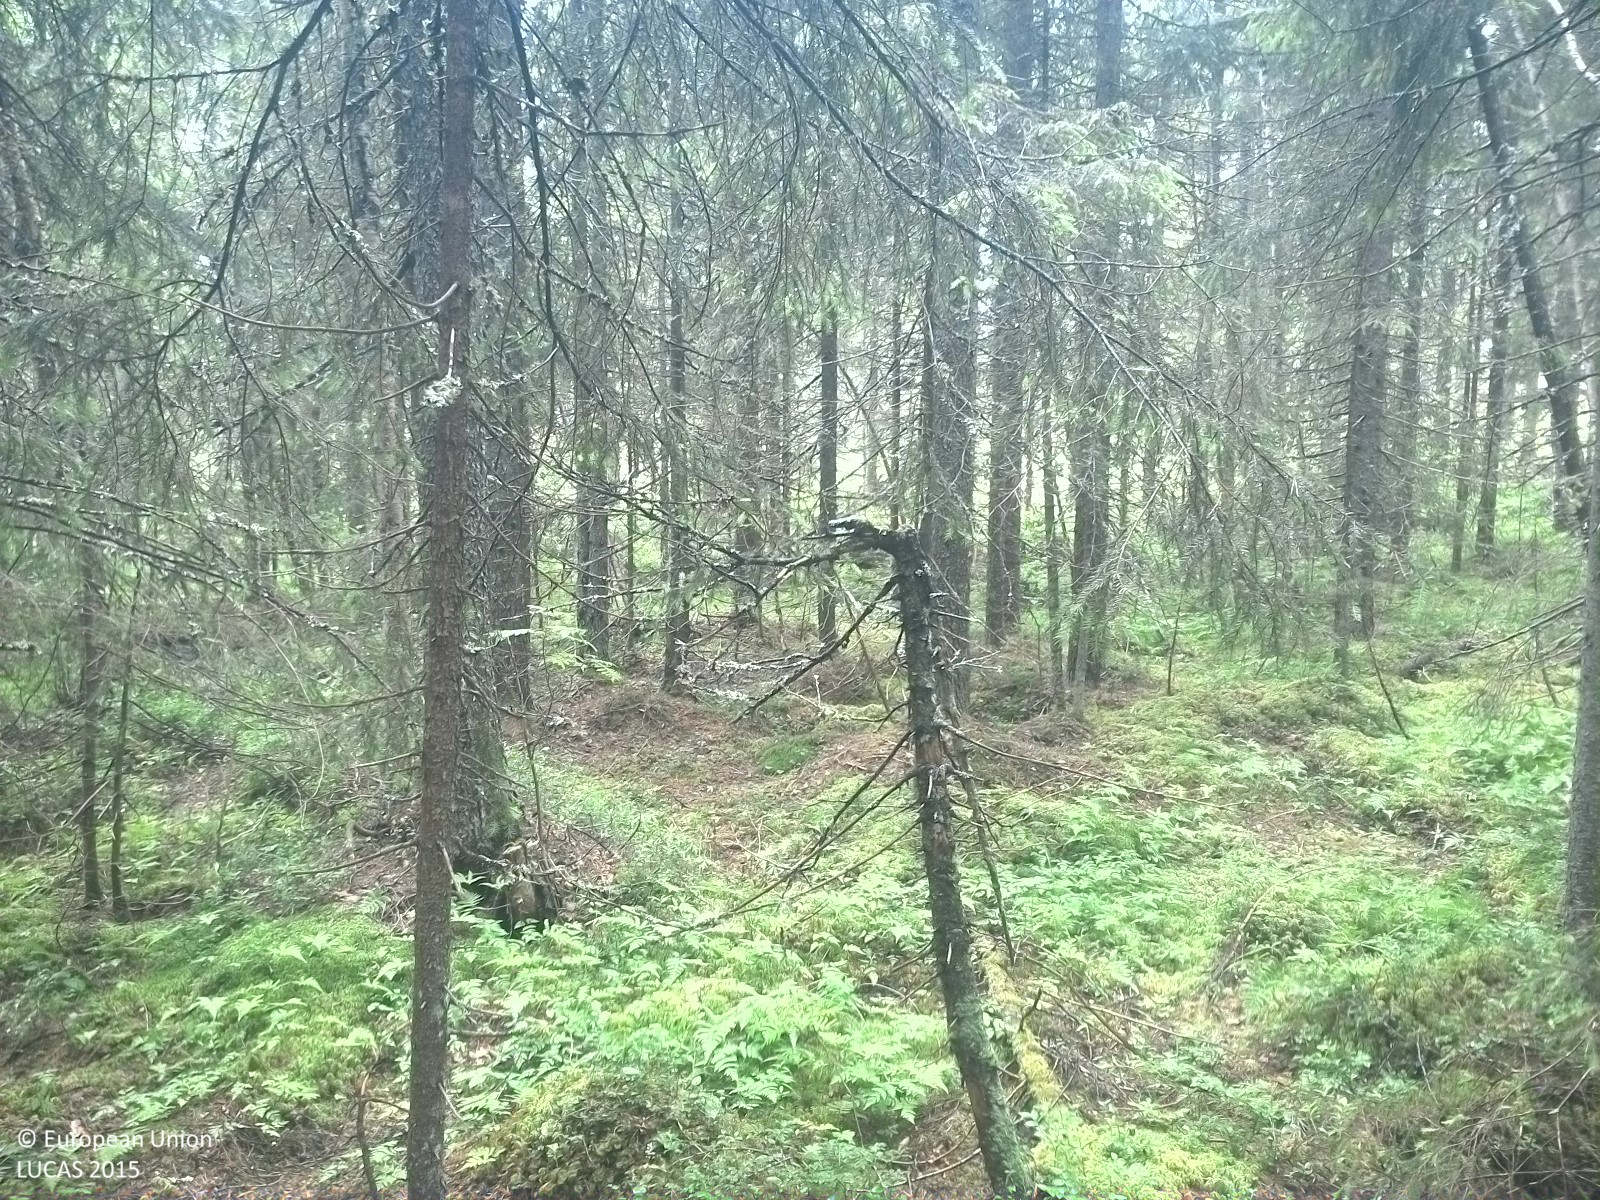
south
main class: Woodland
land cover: Spruce dominated coniferous woodland
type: boreal forest
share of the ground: 50 - 75 %
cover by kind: coniferous forest trees 60 %, lichens and mosses 30 %, herbaceous plants 10 %
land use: Forestry
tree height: > 5 m
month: July
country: SE
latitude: 62.5581
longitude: 17.7410
